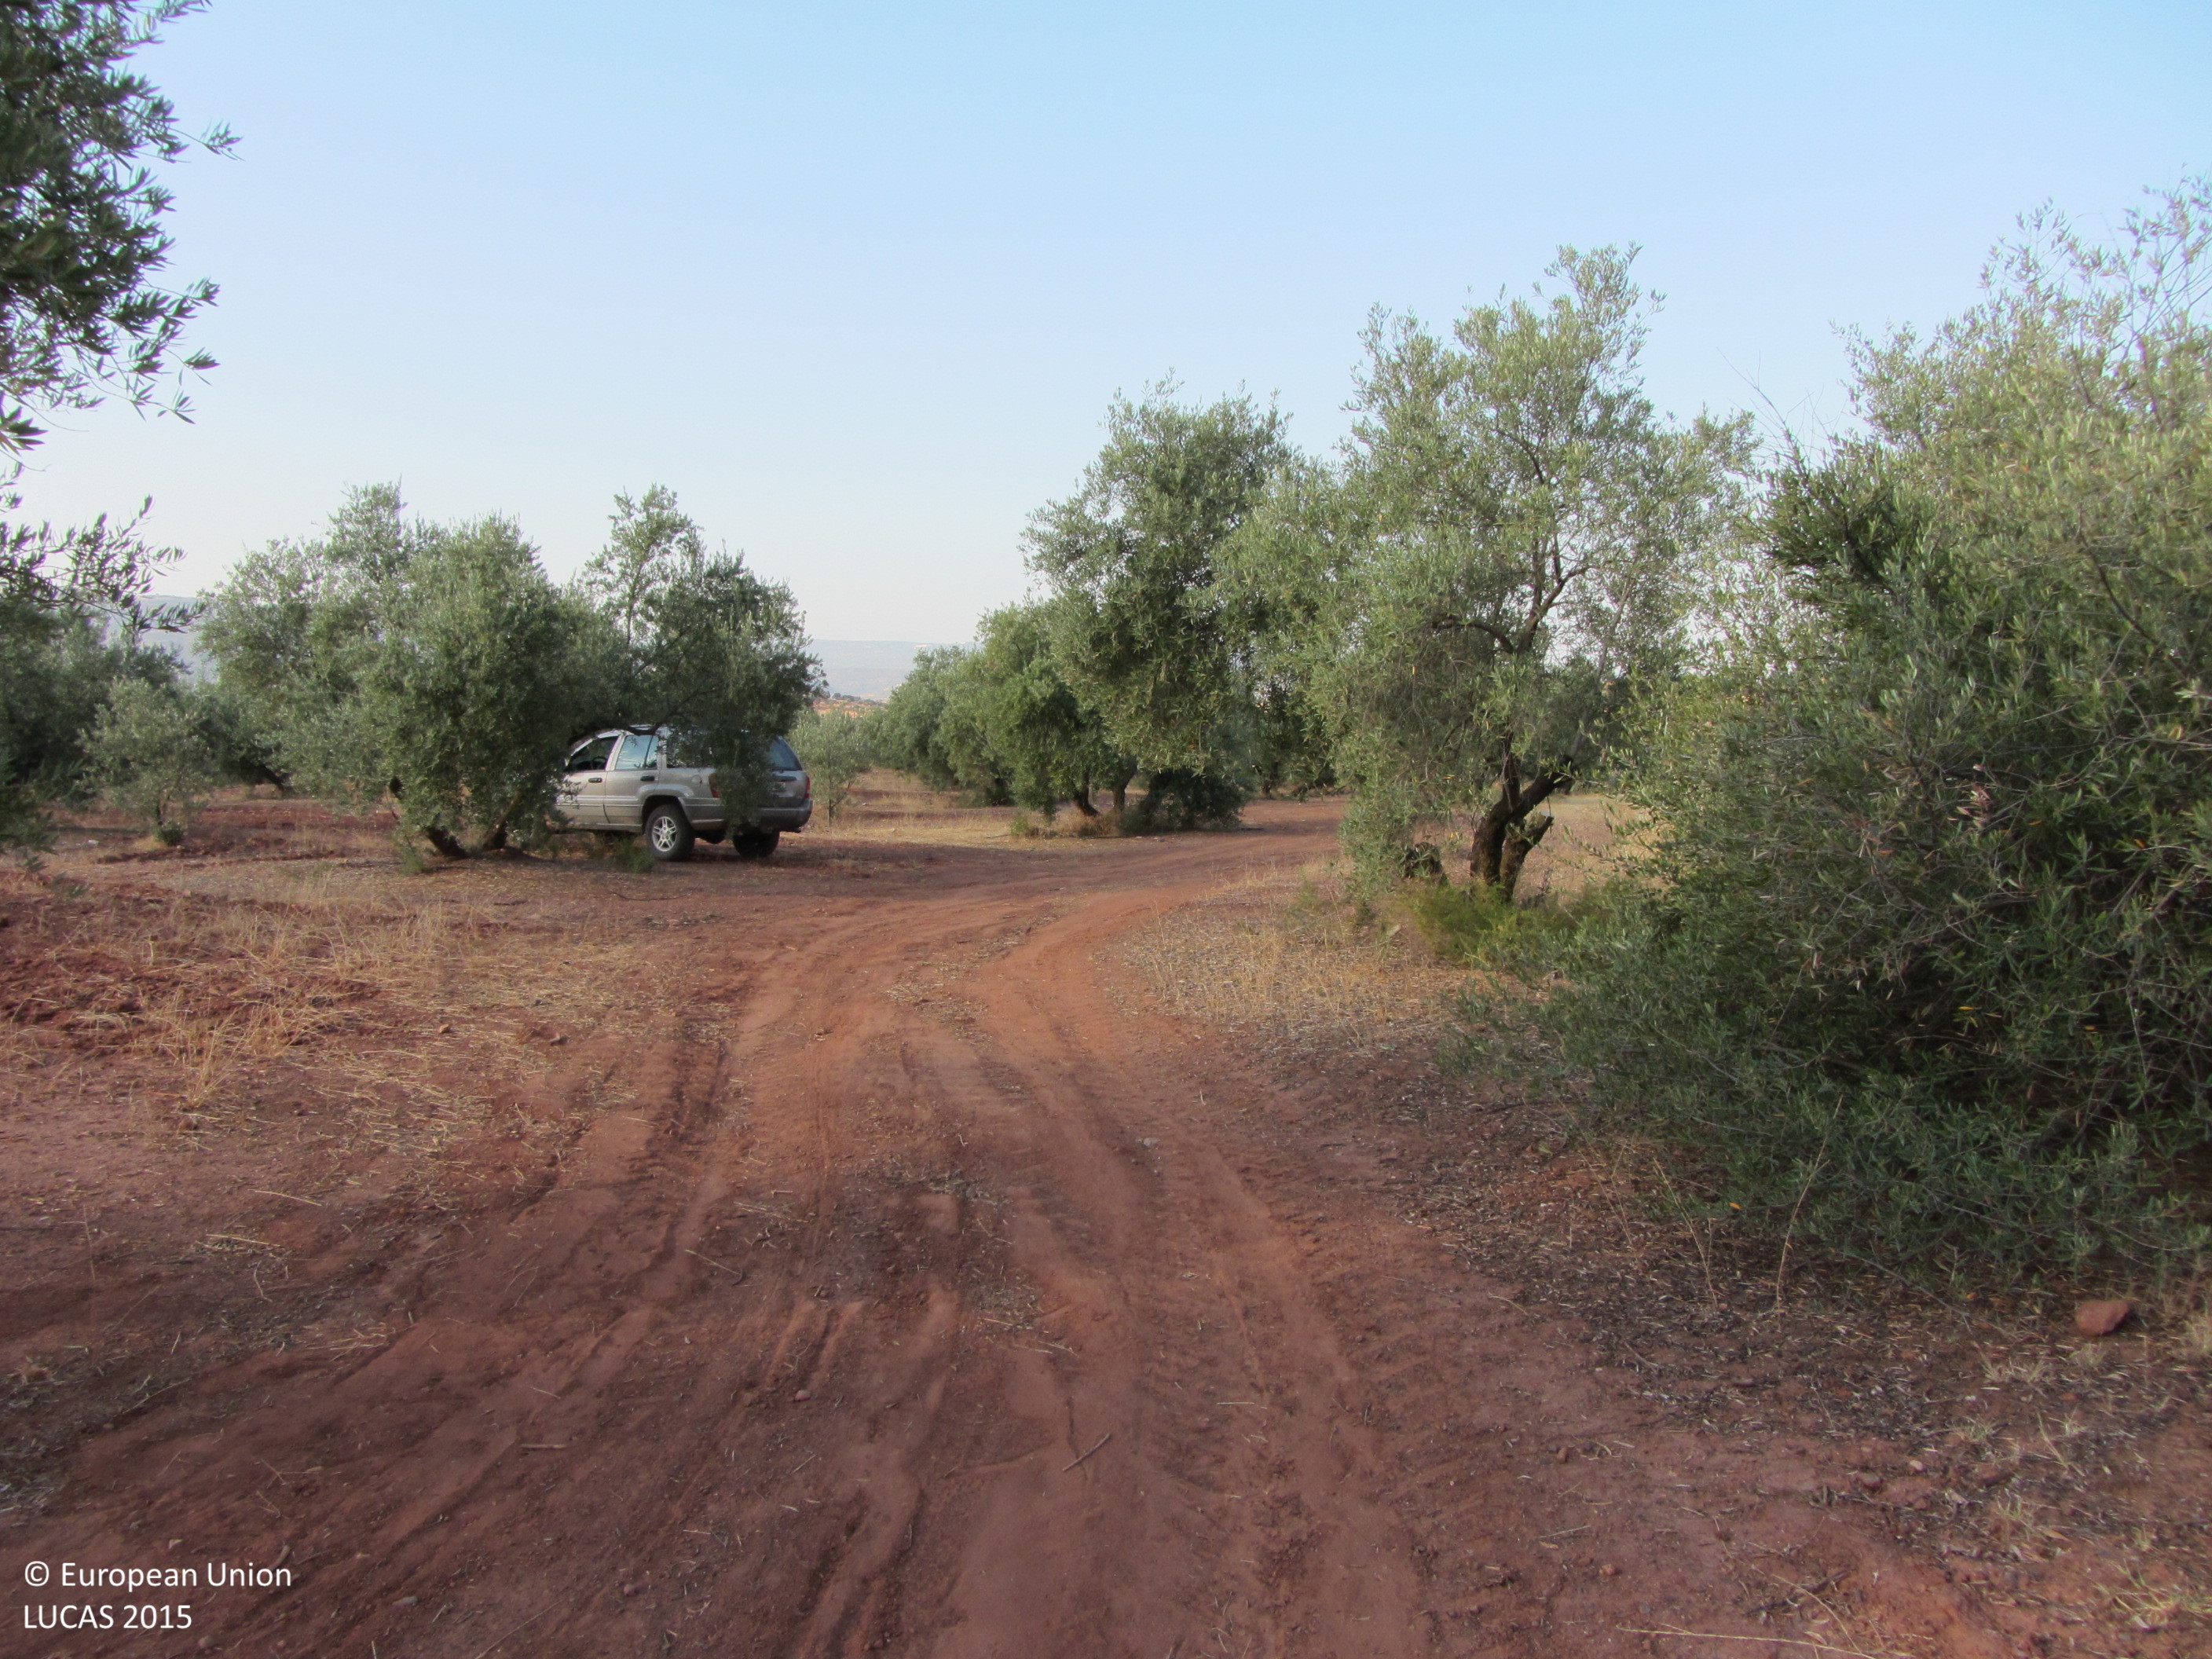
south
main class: Grassland
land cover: Grassland without tree/shrub cover
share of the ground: > 75 %
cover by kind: herbaceous plants 100 %
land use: Agriculture (excluding fallow land and kitchen gardens)
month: June
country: ES
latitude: 38.1476
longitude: -3.4333
